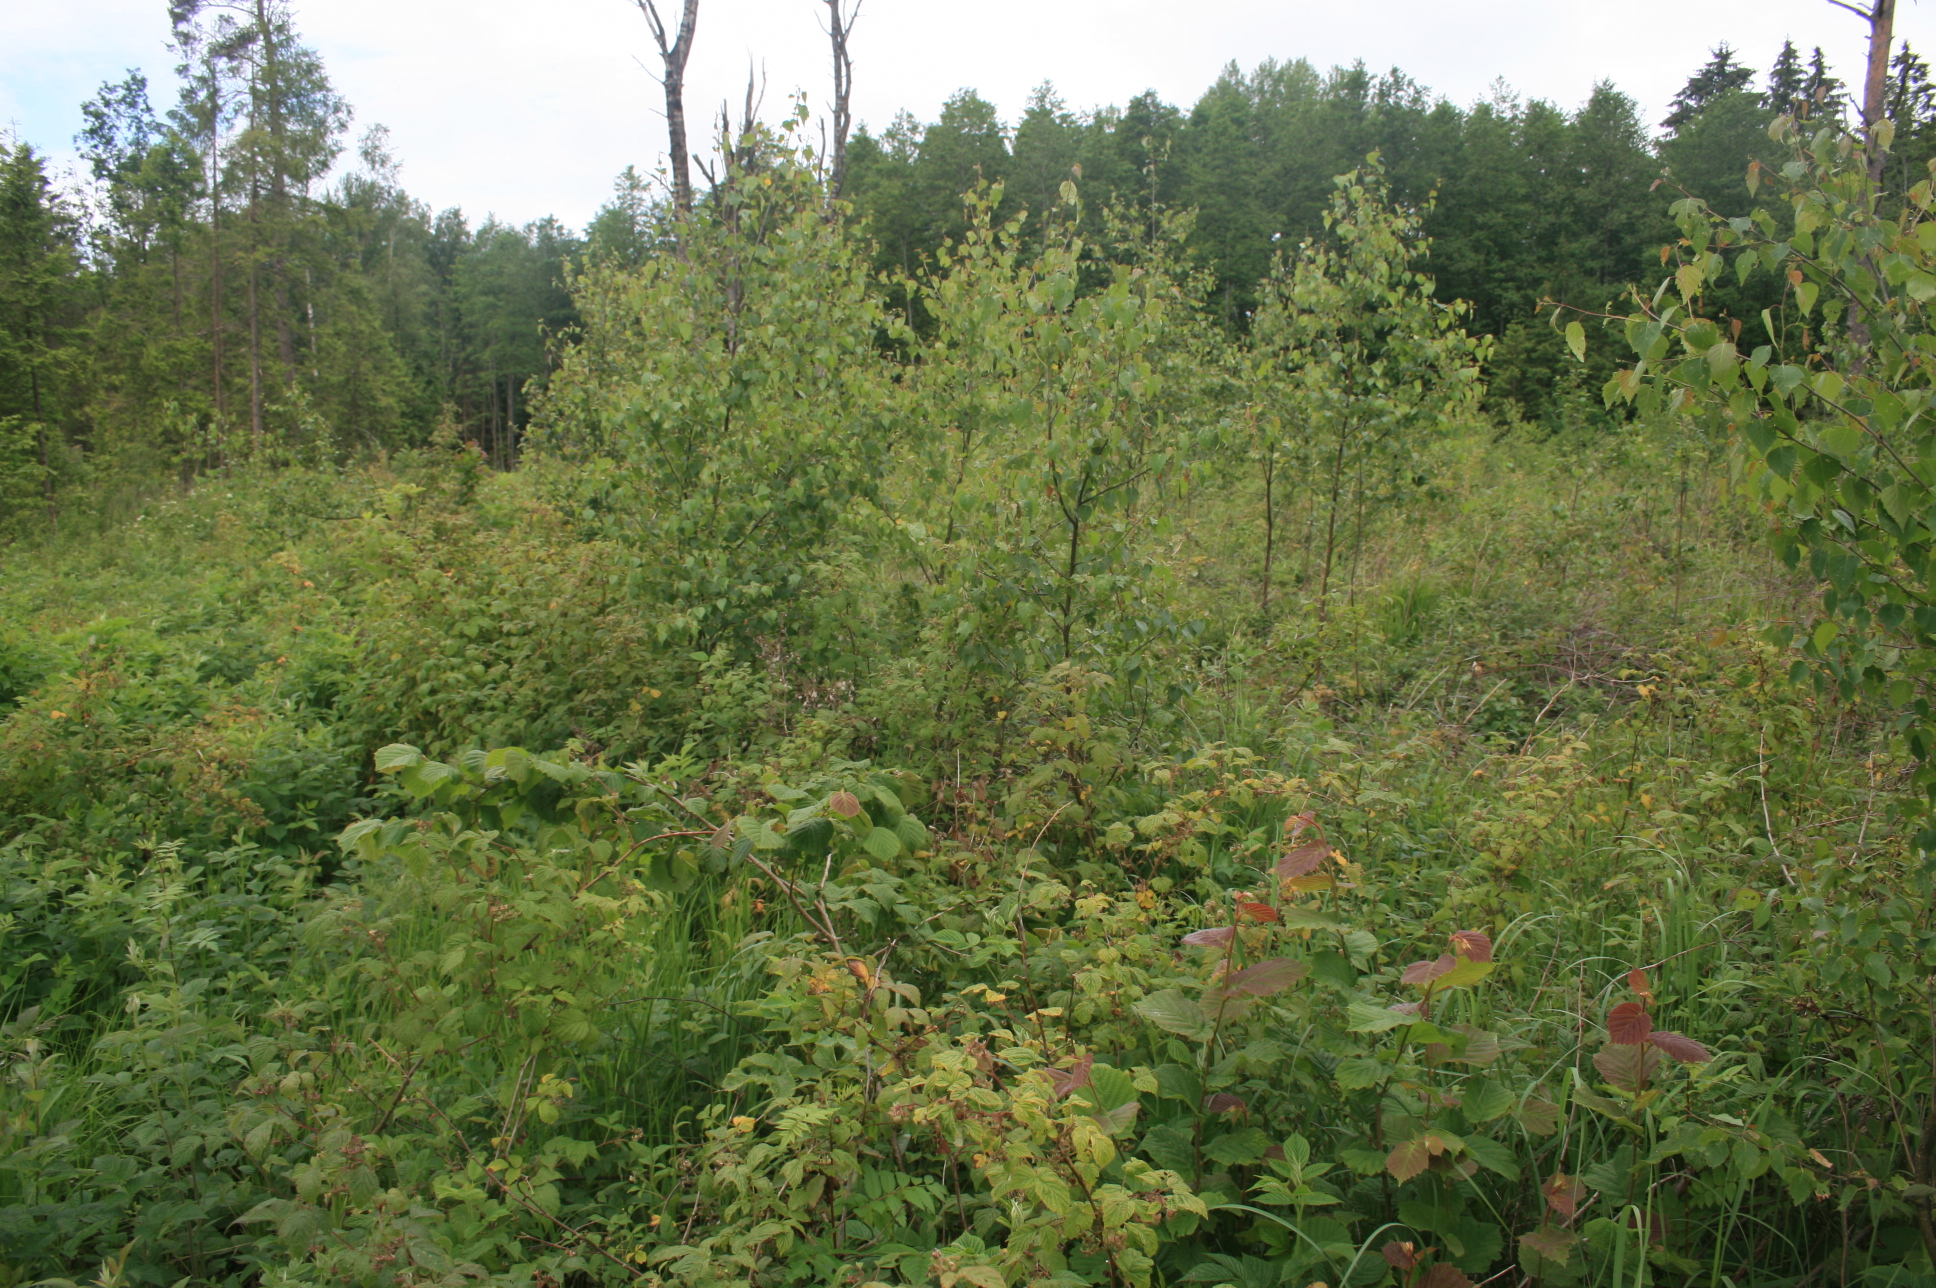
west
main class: Woodland
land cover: Broadleaved woodland
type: non-riverine alder, birch or aspen forest
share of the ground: 25 - 50 %
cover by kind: shrubs 50 %, broadleaved forest trees 30 %, coniferous forest trees 10 %, herbaceous plants 10 %
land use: Forestry
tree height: < 5 m
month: June
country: LT
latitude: 55.2289
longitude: 22.1150
